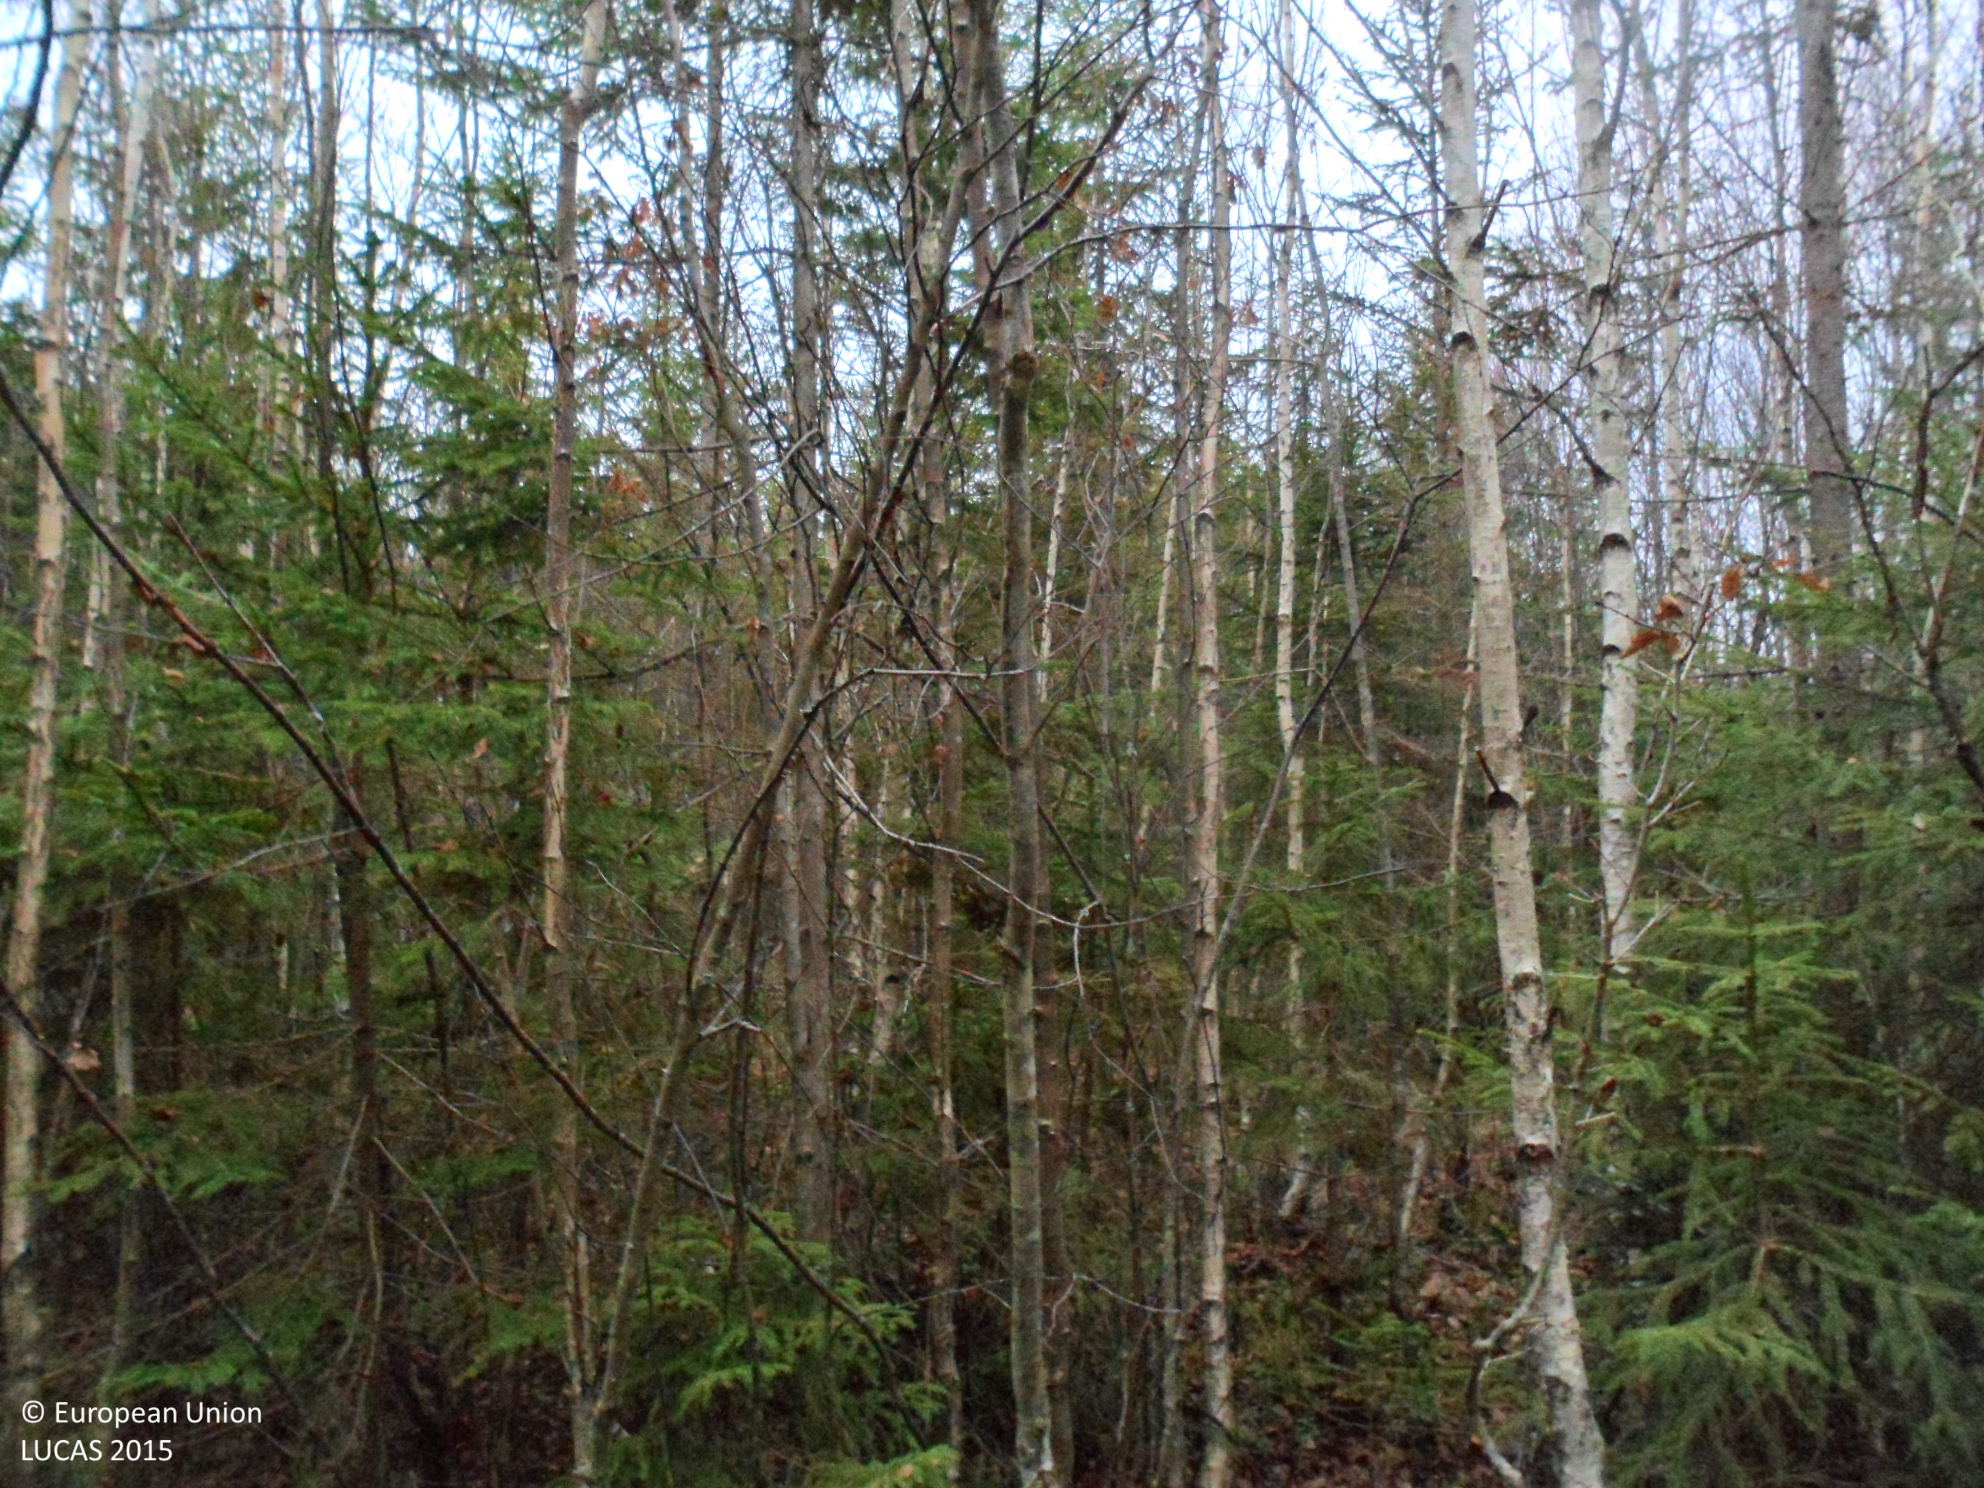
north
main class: Woodland
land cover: Spruce dominated mixed woodland
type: boreal forest
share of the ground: > 75 %
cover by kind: coniferous forest trees 45 %, broadleaved forest trees 30 %, shrubs 10 %, lichens and mosses 10 %, herbaceous plants 5 %
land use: Forestry
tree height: > 5 m
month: November
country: SE
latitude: 56.7701
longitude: 15.9716
